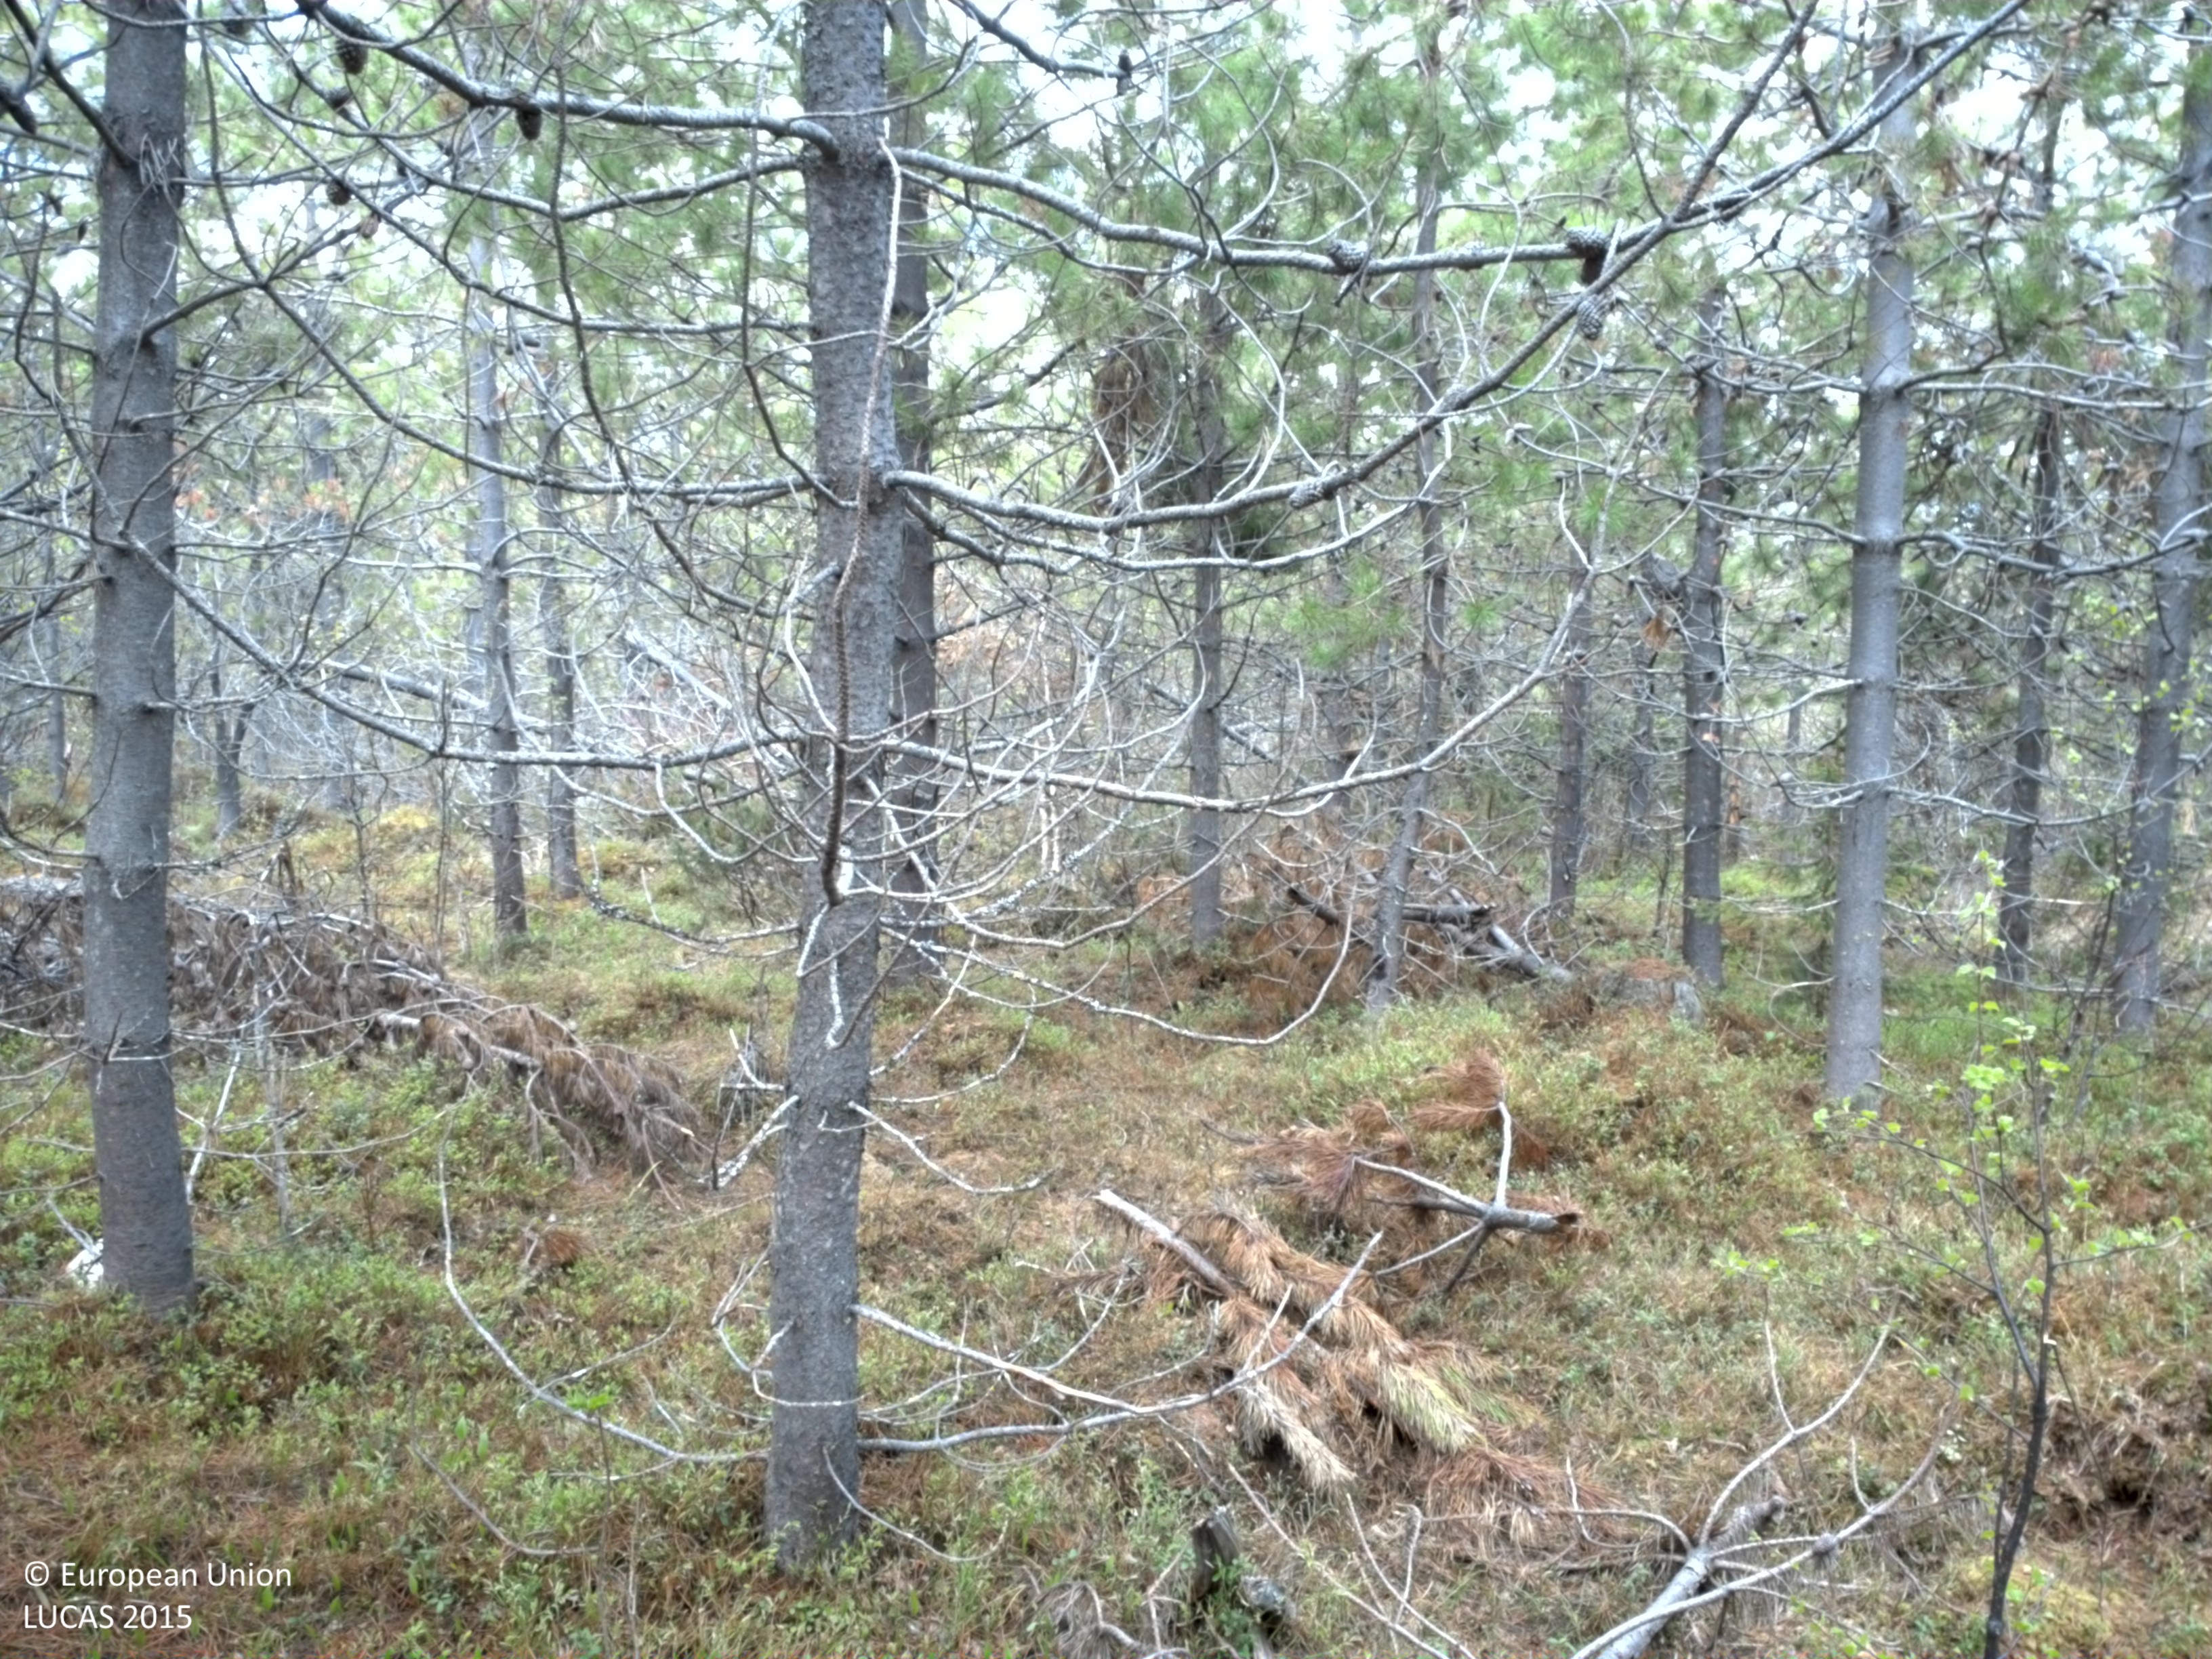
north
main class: Woodland
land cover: Pine dominated coniferous woodland
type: exotic forest
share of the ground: > 75 %
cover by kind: coniferous forest trees 75 %, shrubs 15 %, broadleaved forest trees 5 %, lichens and mosses 5 %
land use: Forestry
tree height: > 5 m
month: June
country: SE
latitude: 66.2667
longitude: 22.2856
